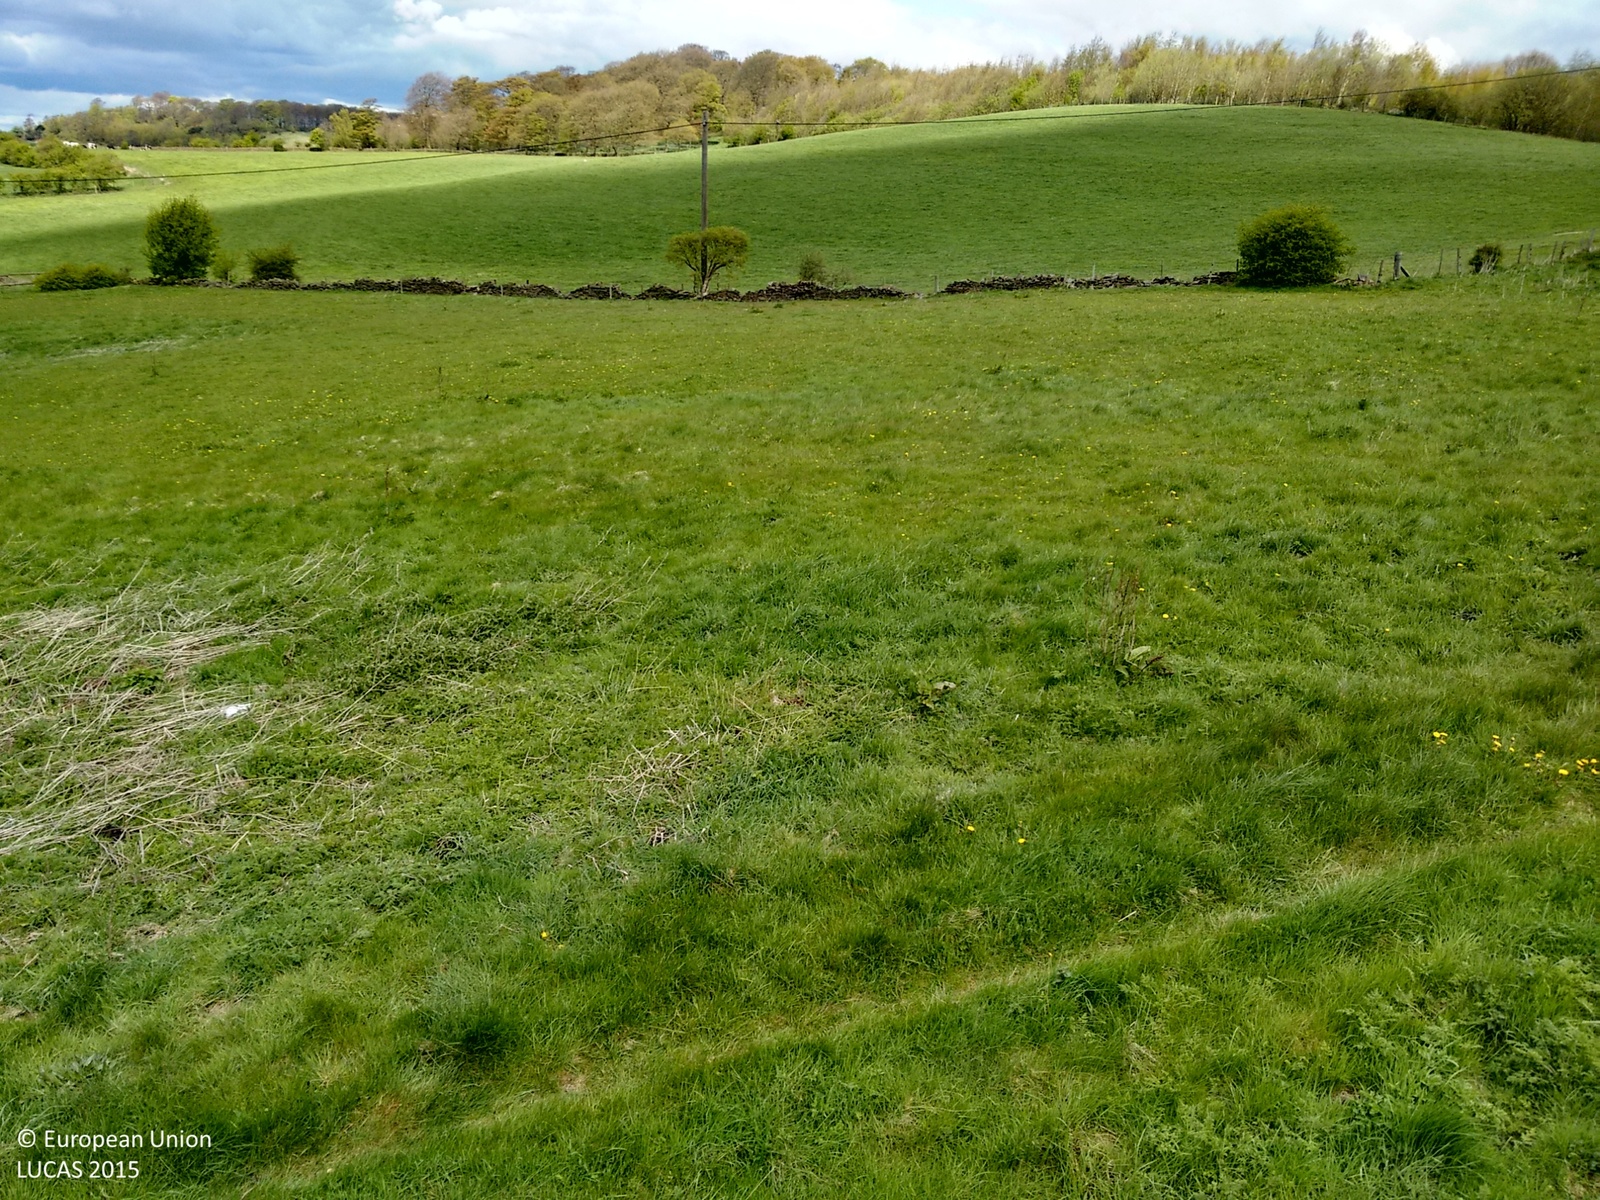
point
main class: Grassland
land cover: Grassland without tree/shrub cover
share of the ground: > 75 %
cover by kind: herbaceous plants 100 %
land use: Agriculture (excluding fallow land and kitchen gardens)
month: April
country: GB
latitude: 53.6339
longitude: -1.6822
